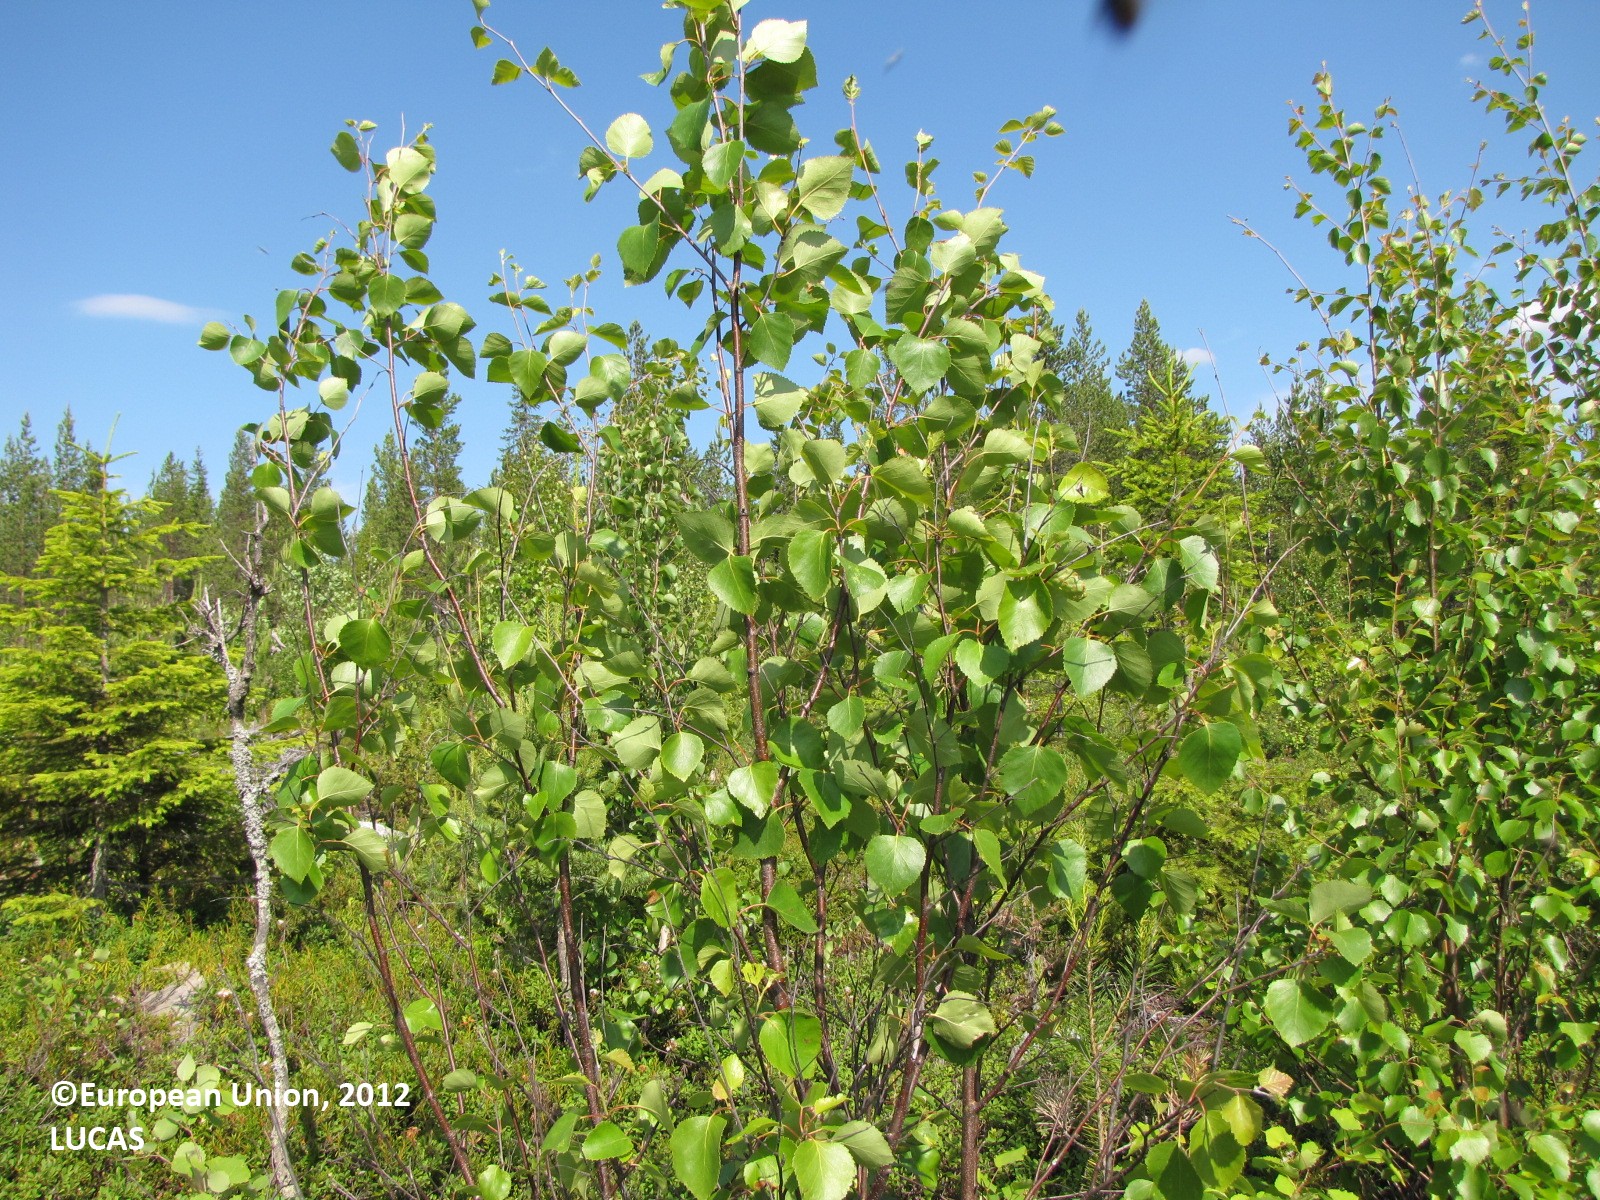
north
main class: Woodland
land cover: Other mixed woodland
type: boreal forest
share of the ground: 25 - 50 %
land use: Forestry
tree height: < 5 m
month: July
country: FI
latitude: 66.2571
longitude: 25.3097
